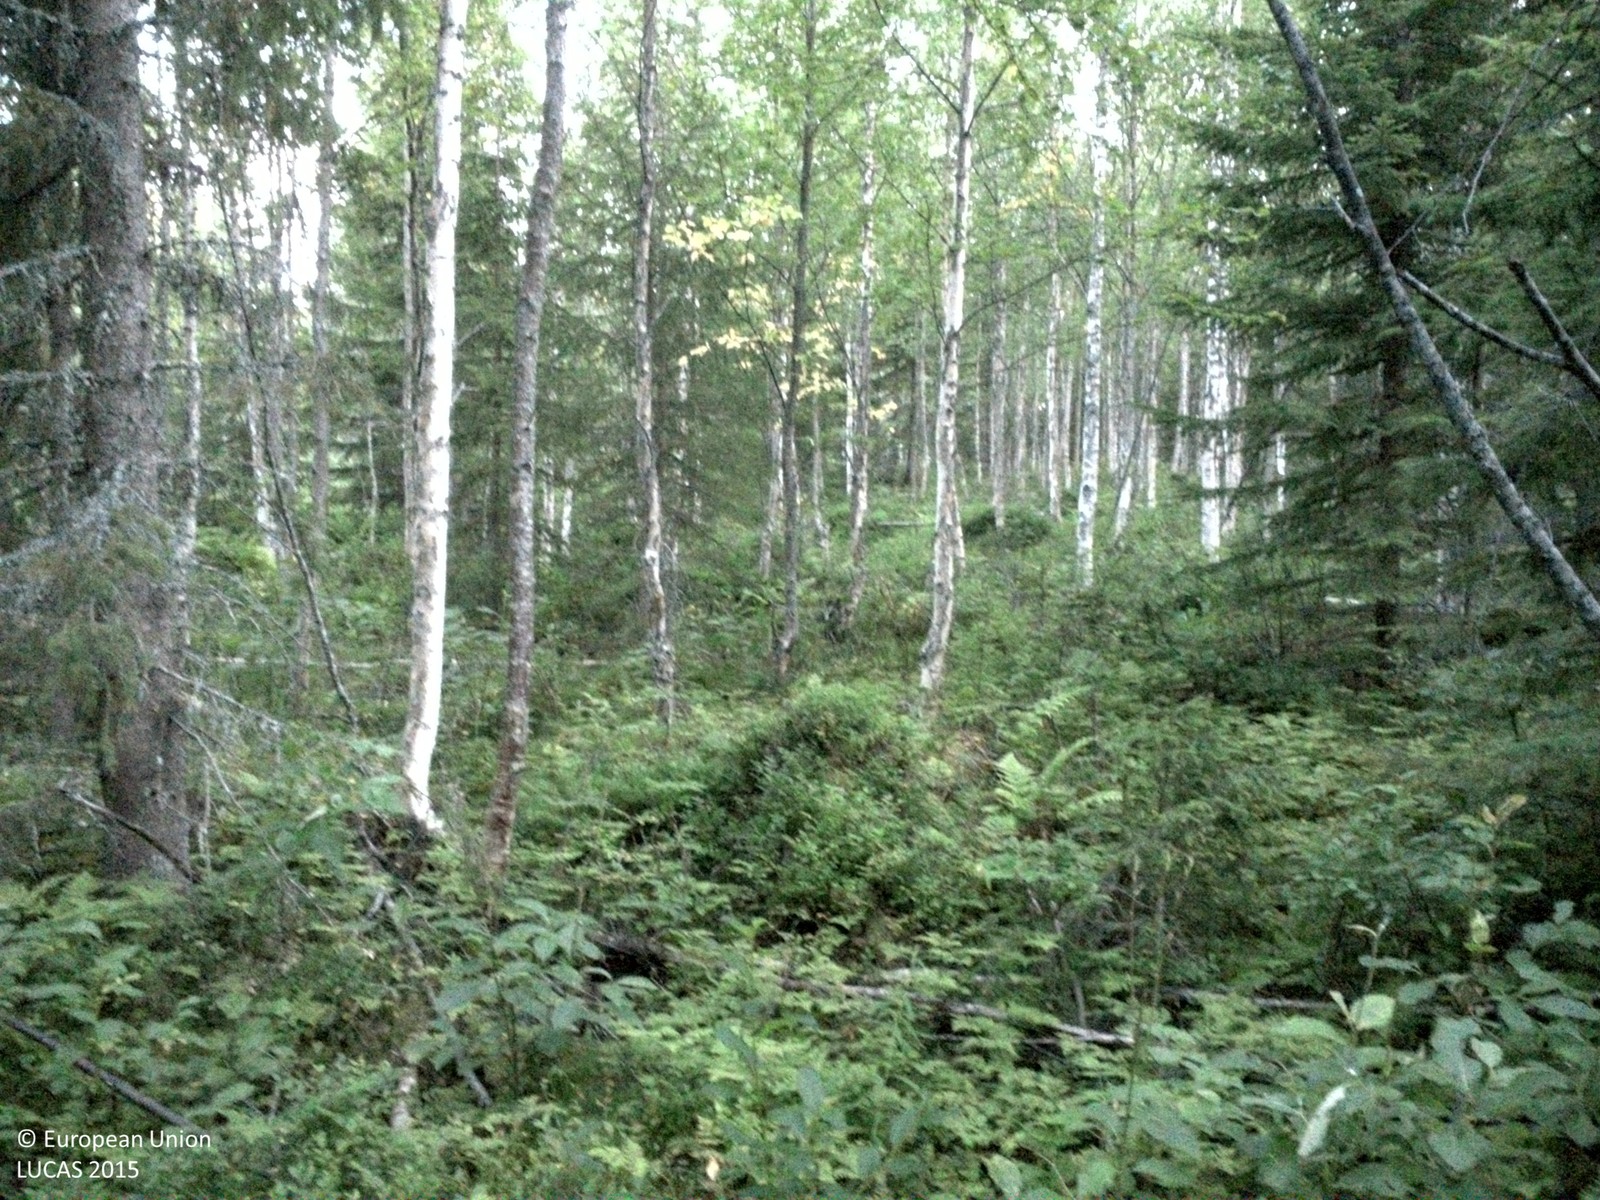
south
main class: Woodland
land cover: Spruce dominated mixed woodland
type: boreal forest
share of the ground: 50 - 75 %
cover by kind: coniferous forest trees 45 %, shrubs 20 %, herbaceous plants 20 %, broadleaved forest trees 15 %
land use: Forestry
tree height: > 5 m
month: August
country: SE
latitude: 64.3575
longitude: 18.7307
